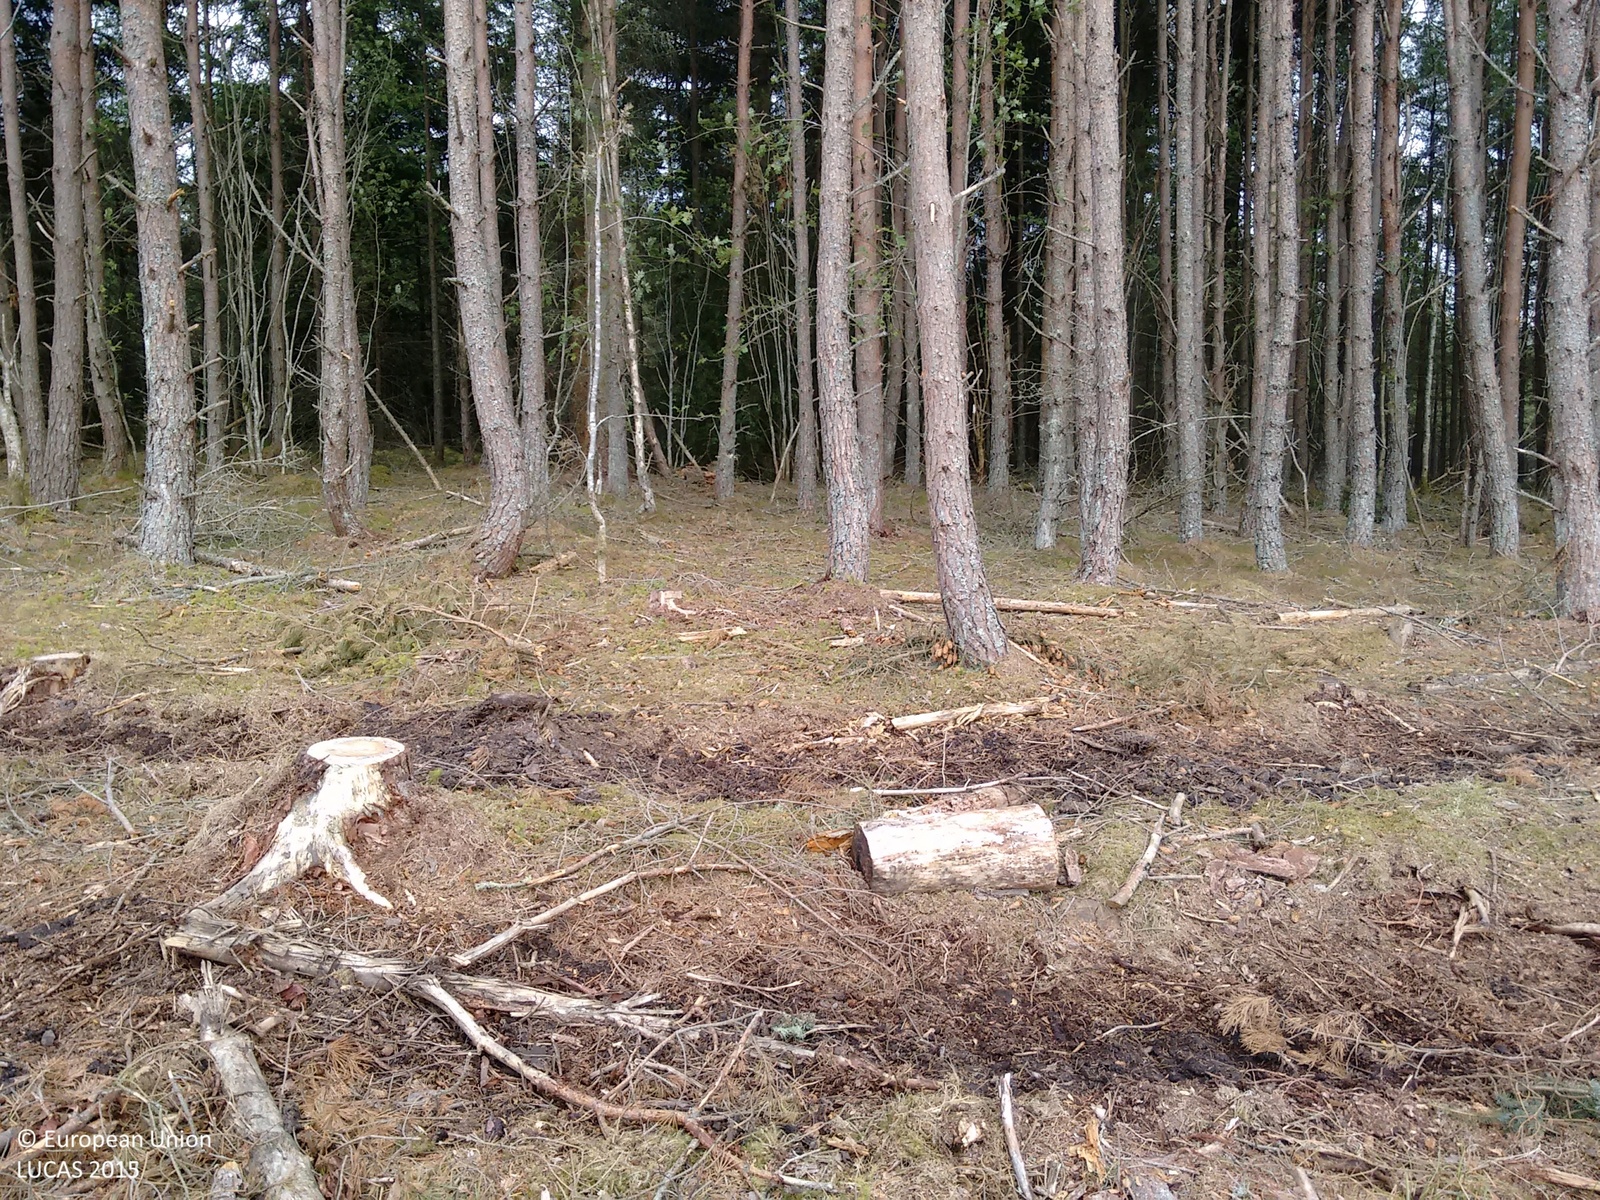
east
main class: Grassland
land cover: Grassland with sparse tree/shrub cover
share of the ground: > 75 %
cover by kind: herbaceous plants 50 %, lichens and mosses 25 %, unconsolidated bare surface 20 %, broadleaved forest trees 5 %
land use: Forestry
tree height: > 5 m
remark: Clear cut
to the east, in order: Grassland with sparse tree/shrub cover; Pine dominated mixed woodland; Pine dominated coniferous woodland; Tracks; Pine dominated coniferous woodland; Shrubland without tree cover; Tracks; Shruby margins; Fences; Grassland without tree/shrub cover
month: August
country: GB
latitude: 57.6514
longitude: -2.8771
